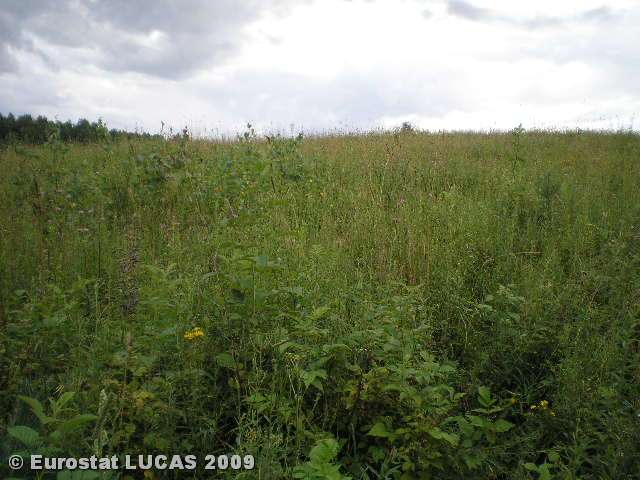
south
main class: Woodland
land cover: Broadleaved woodland
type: hemiboreal forest and nemoral coniferous forest and mixed broadleaved-coniferous forest
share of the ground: > 75 %
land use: Forestry
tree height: > 5 m
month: July
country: LT
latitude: 54.9839
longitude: 25.3264
